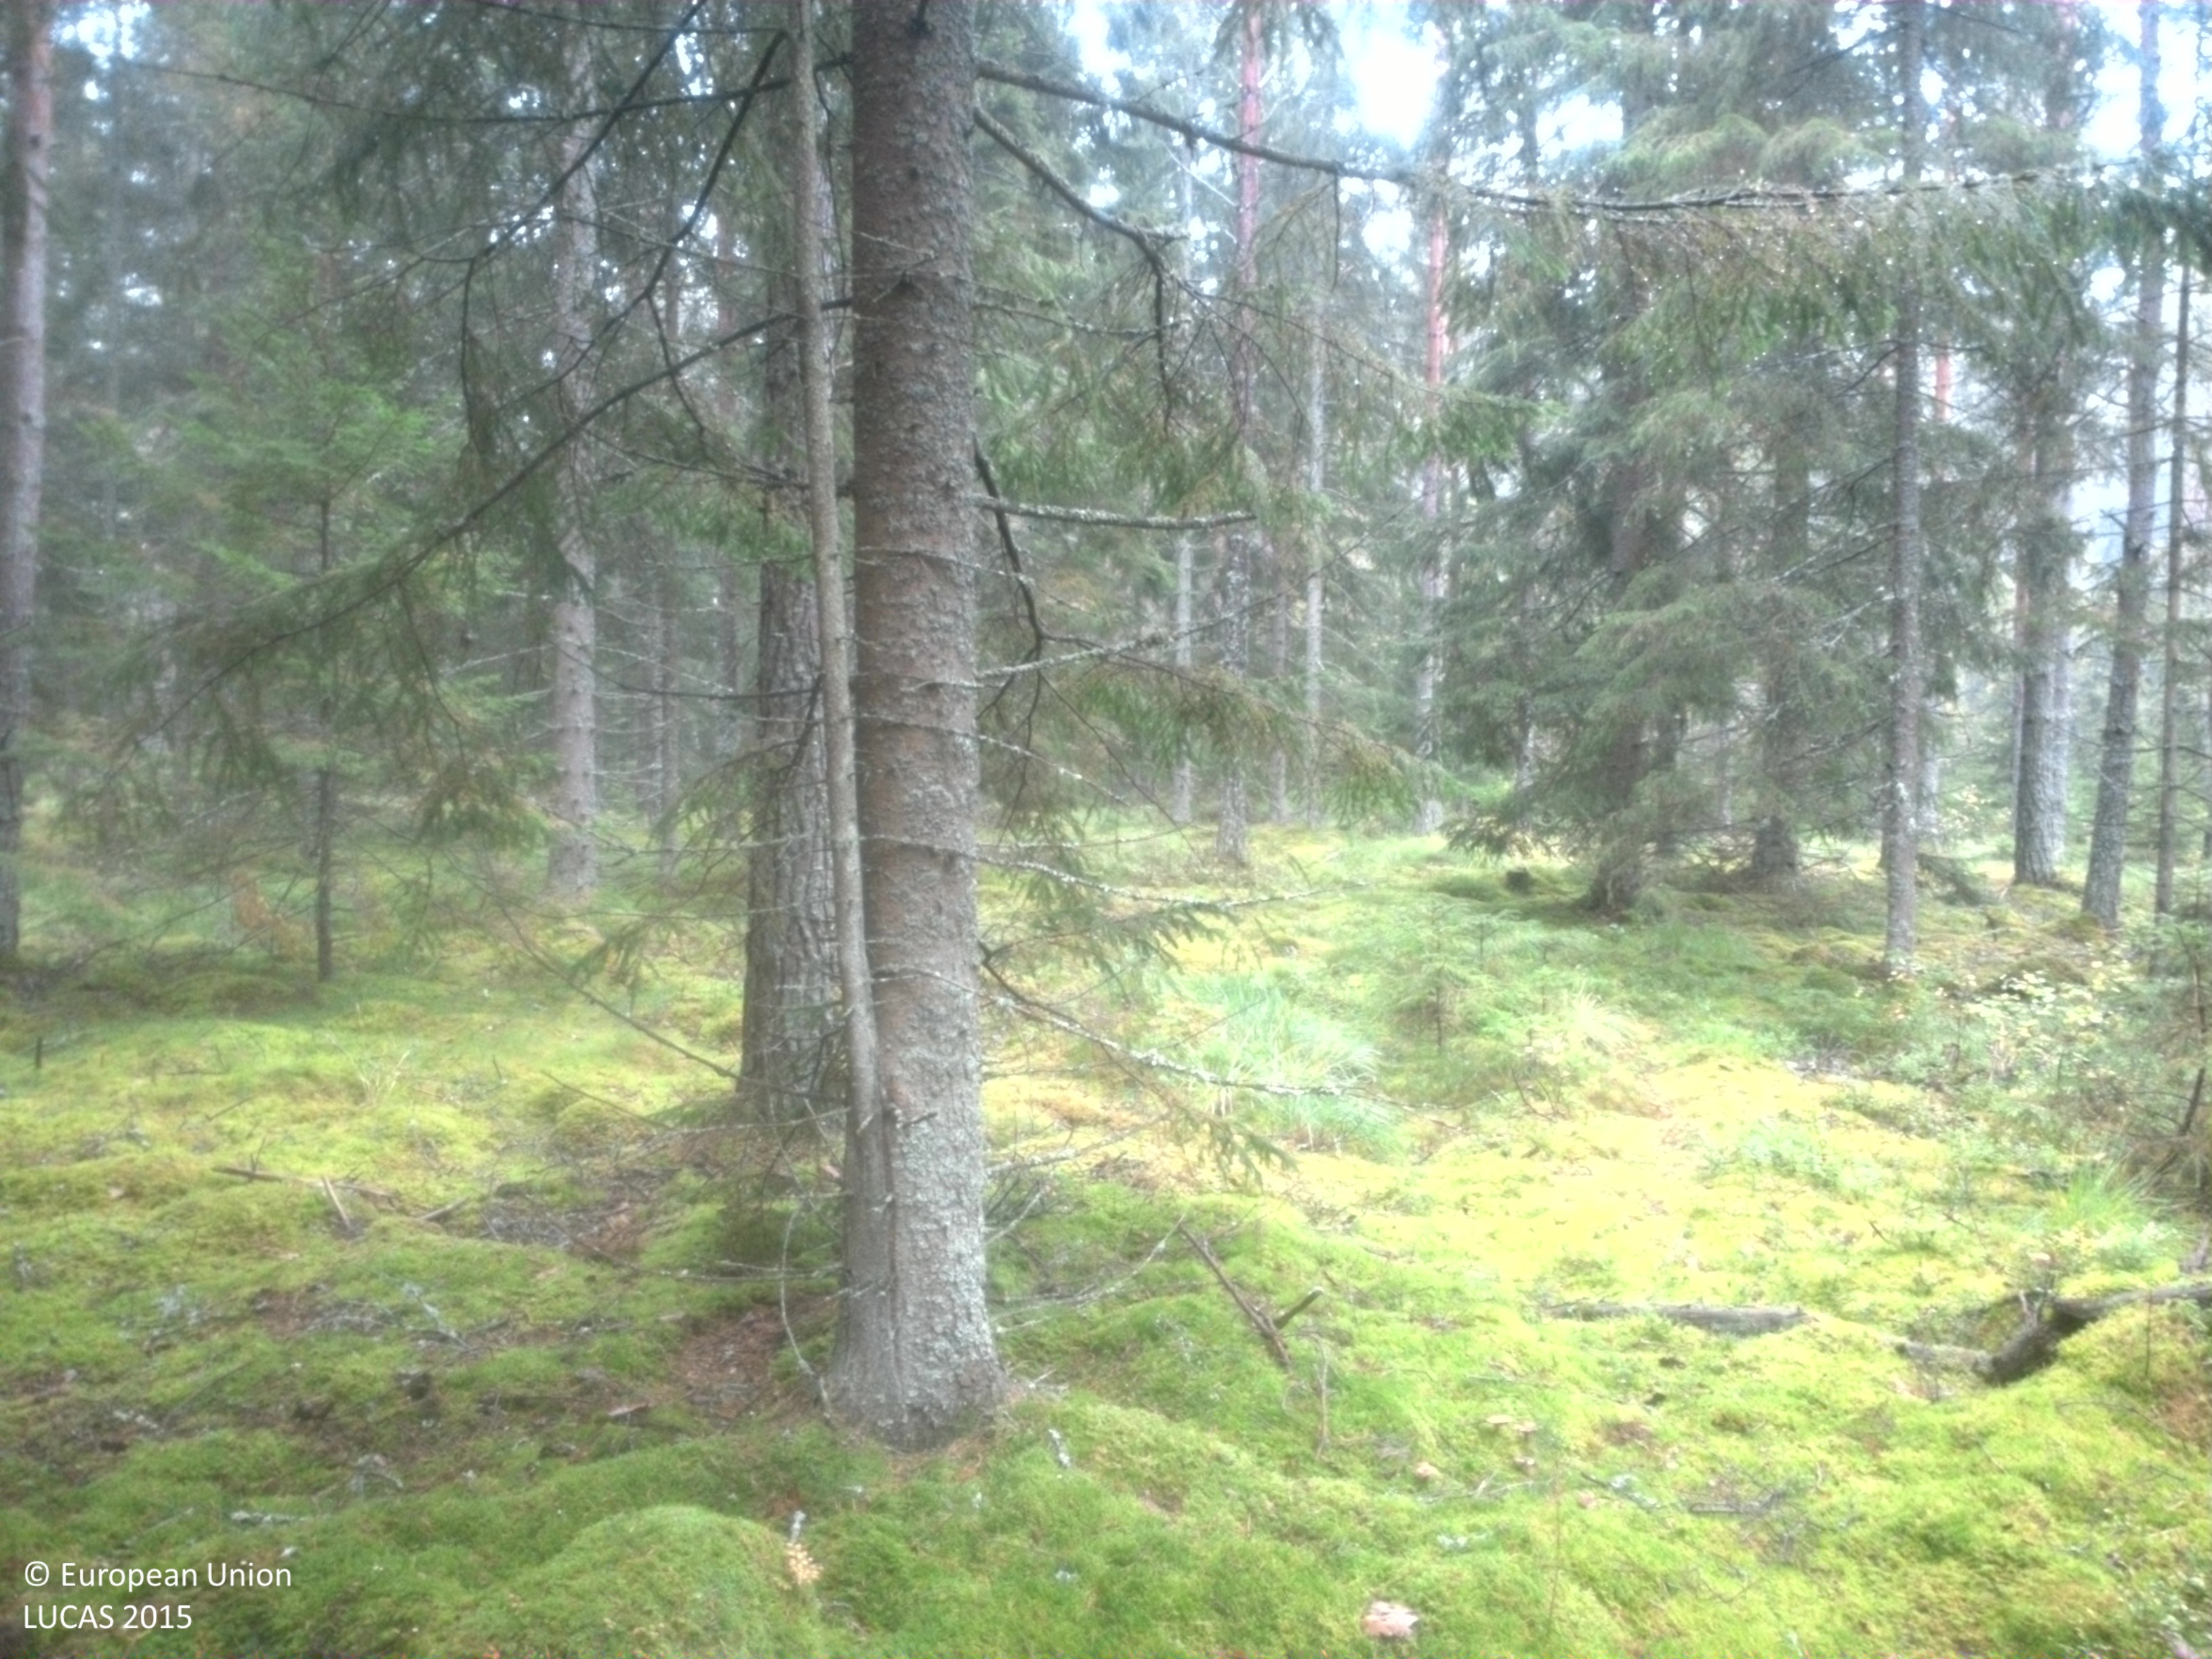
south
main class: Woodland
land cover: Spruce dominated coniferous woodland
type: boreal forest
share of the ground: 50 - 75 %
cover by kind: coniferous forest trees 50 %, lichens and mosses 40 %, shrubs 5 %, herbaceous plants 5 %
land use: Forestry
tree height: > 5 m
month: September
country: SE
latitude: 58.1812
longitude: 13.2087
